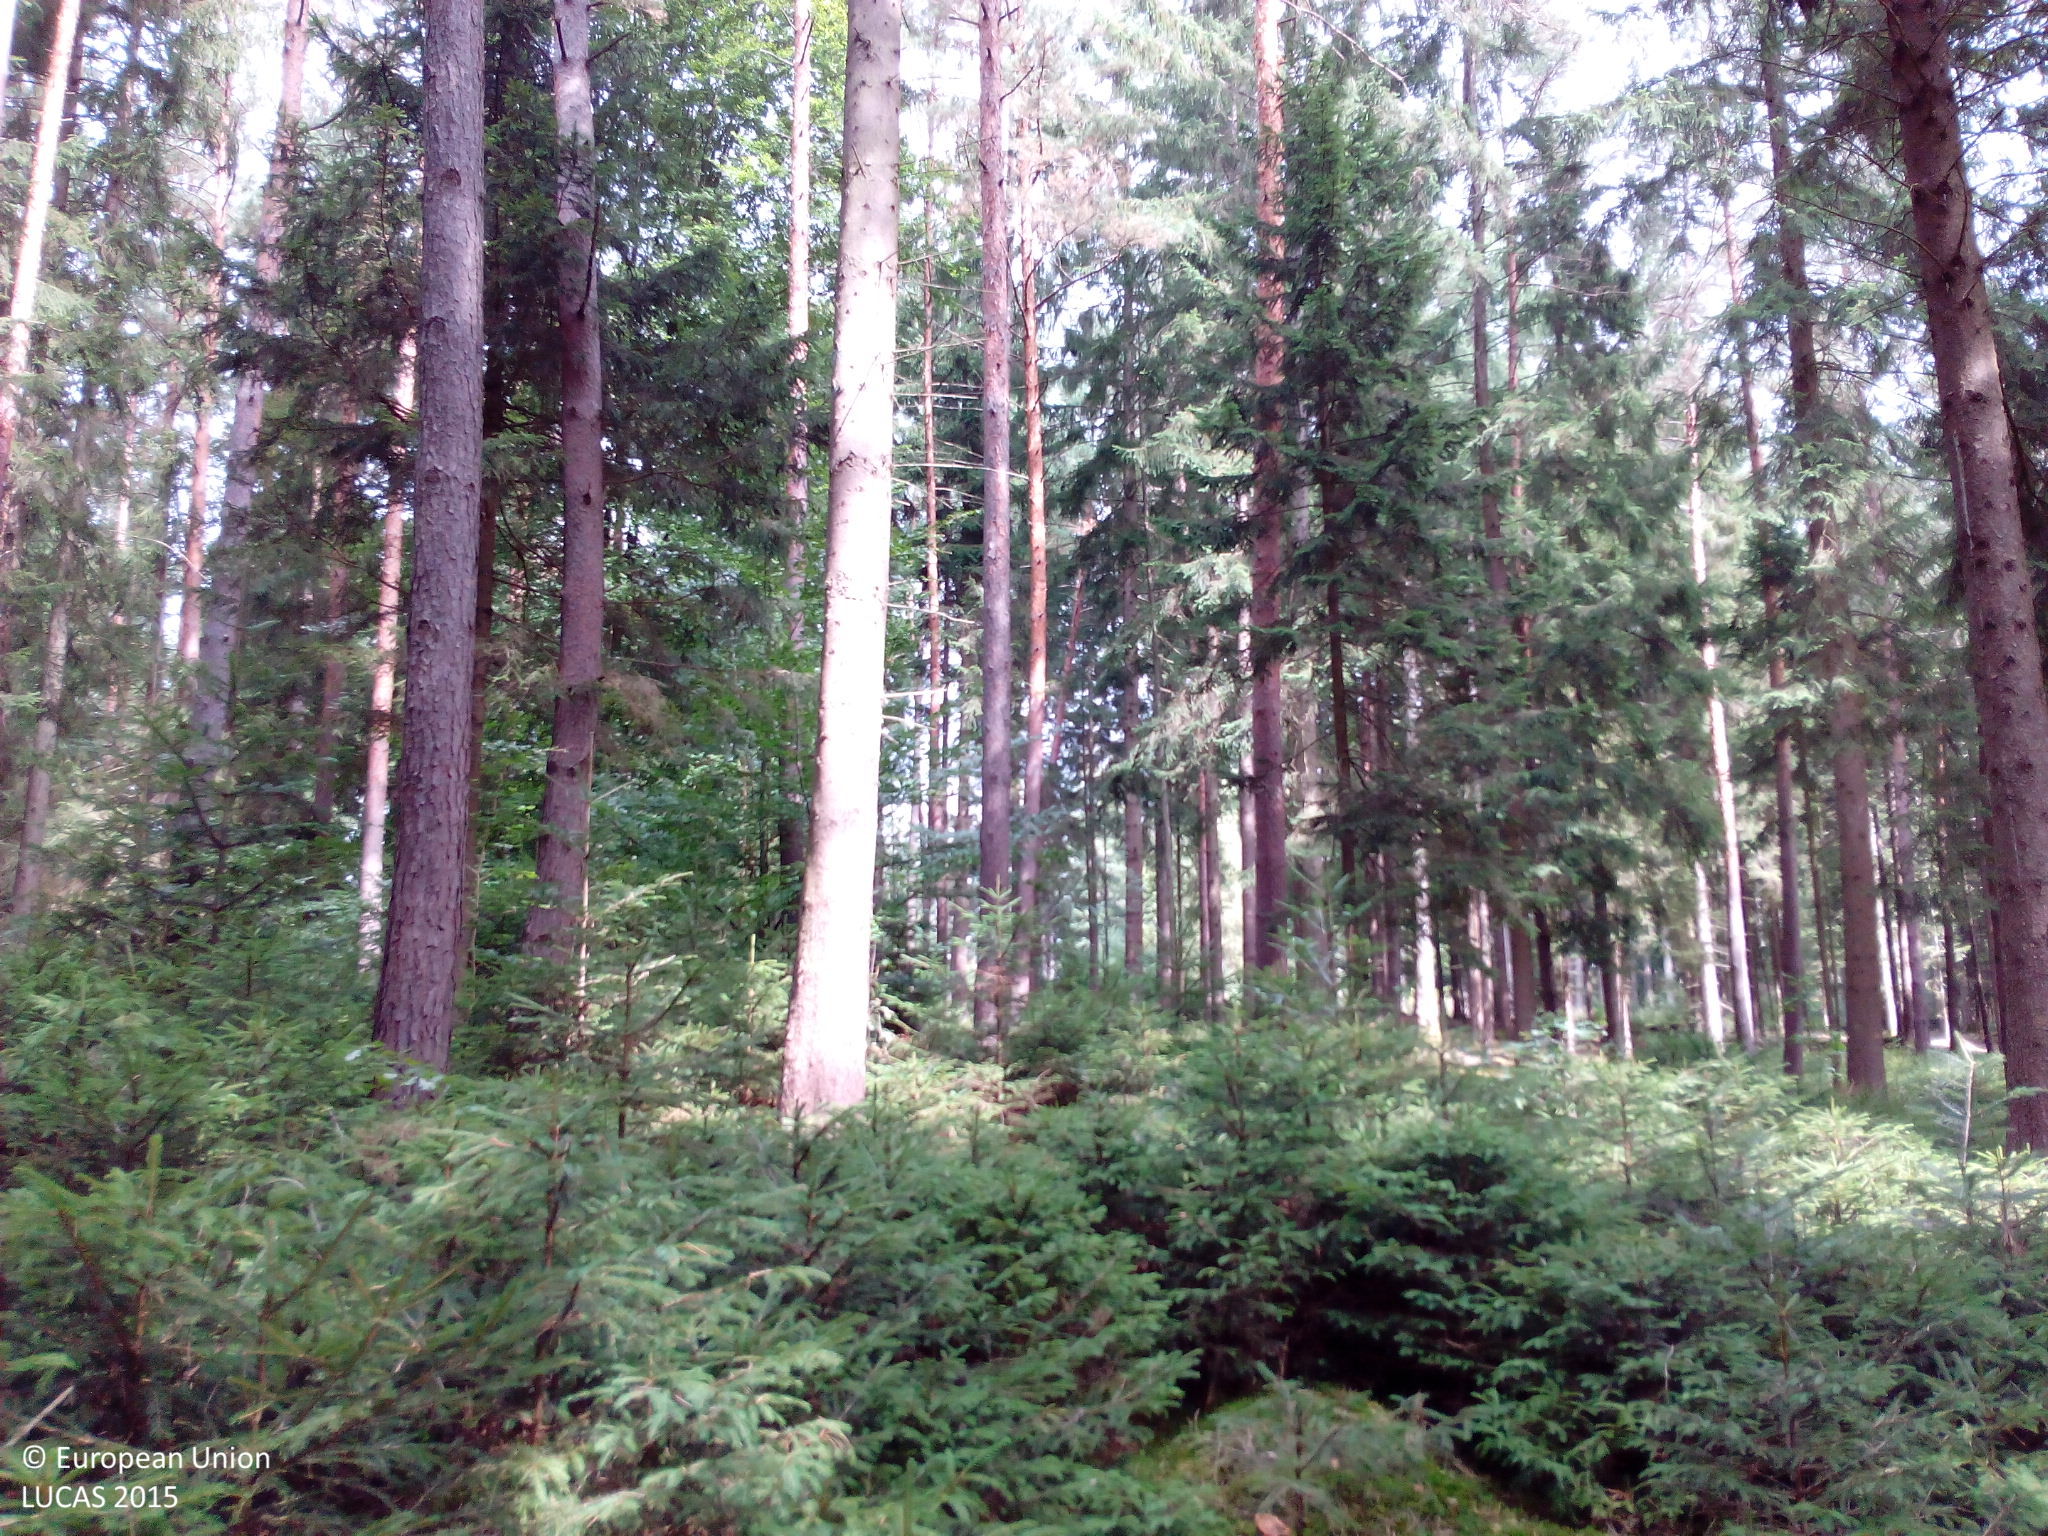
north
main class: Woodland
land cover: Spruce dominated coniferous woodland
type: hemiboreal forest and nemoral coniferous forest and mixed broadleaved-coniferous forest
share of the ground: 50 - 75 %
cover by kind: coniferous forest trees 60 %, lichens and mosses 20 %, shrubs 10 %, broadleaved forest trees 5 %, herbaceous plants 5 %
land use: Forestry
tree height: > 5 m
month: September
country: DE
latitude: 48.3058
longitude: 8.6929
